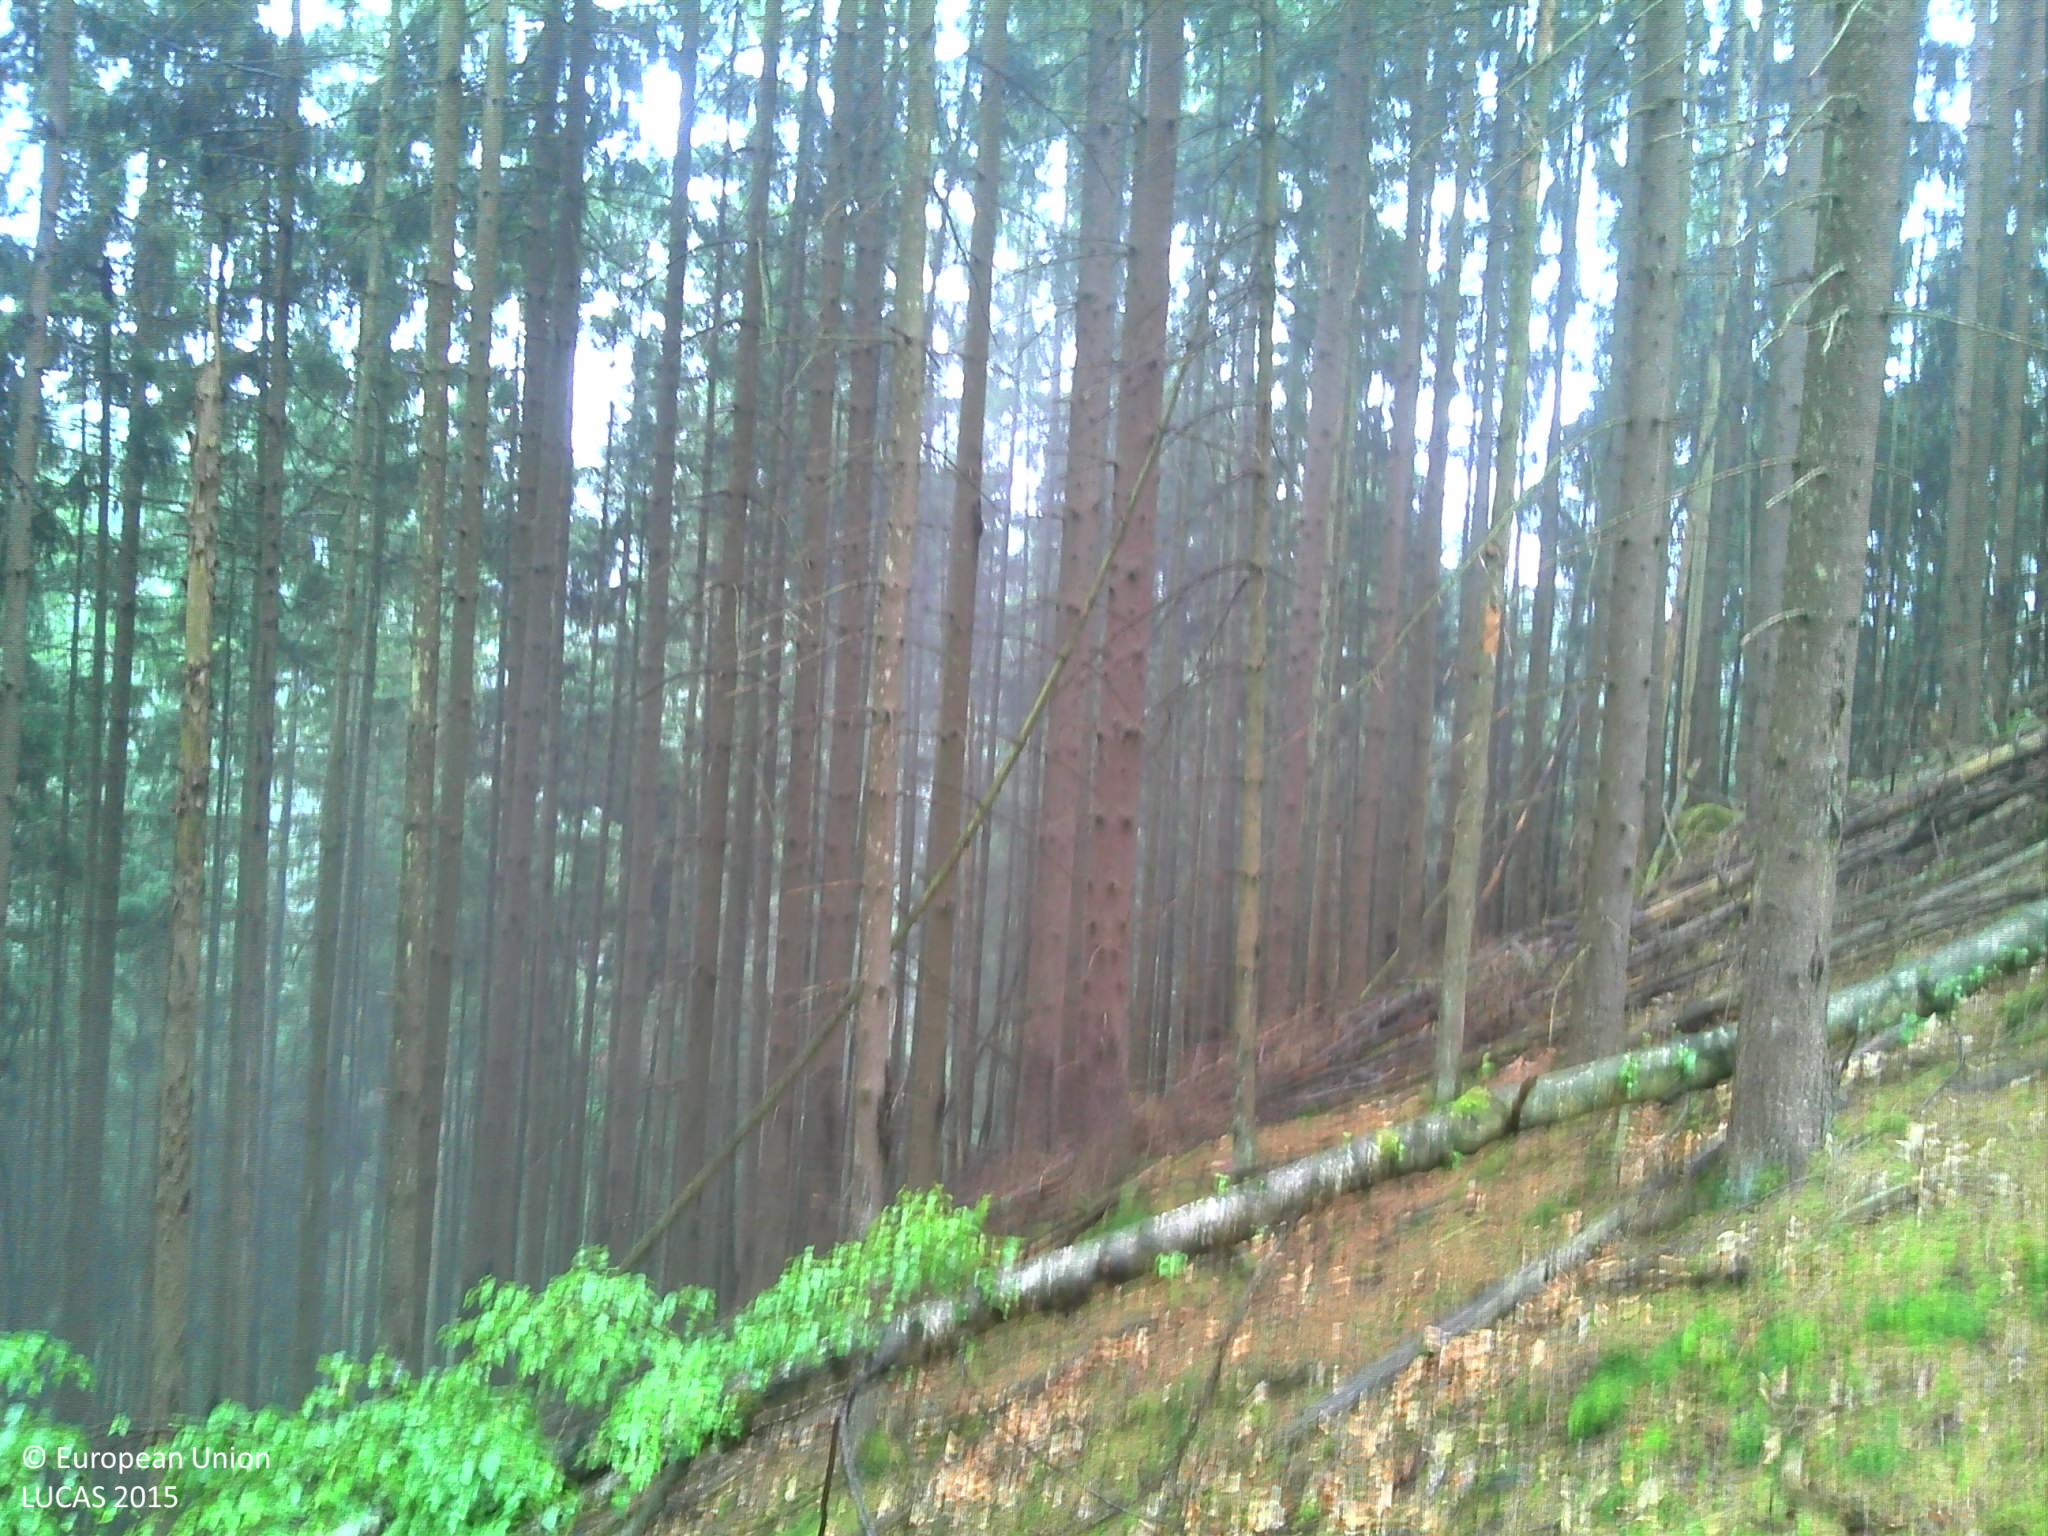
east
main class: Woodland
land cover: Spruce dominated mixed woodland
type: beech forest
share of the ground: > 75 %
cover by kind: coniferous forest trees 65 %, broadleaved forest trees 25 %, shrubs 5 %, herbaceous plants 5 %
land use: Forestry
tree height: > 5 m
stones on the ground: < 10 %
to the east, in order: Spruce dominated mixed woodland; Rock outcrops; Spruce dominated coniferous woodland; Tracks; Broadleaved woodland; Rivers and streams; Broadleaved woodland; Tracks; Ditches and canals; Spruce dominated mixed woodland
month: June
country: FR
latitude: 48.9919
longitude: 7.7183
